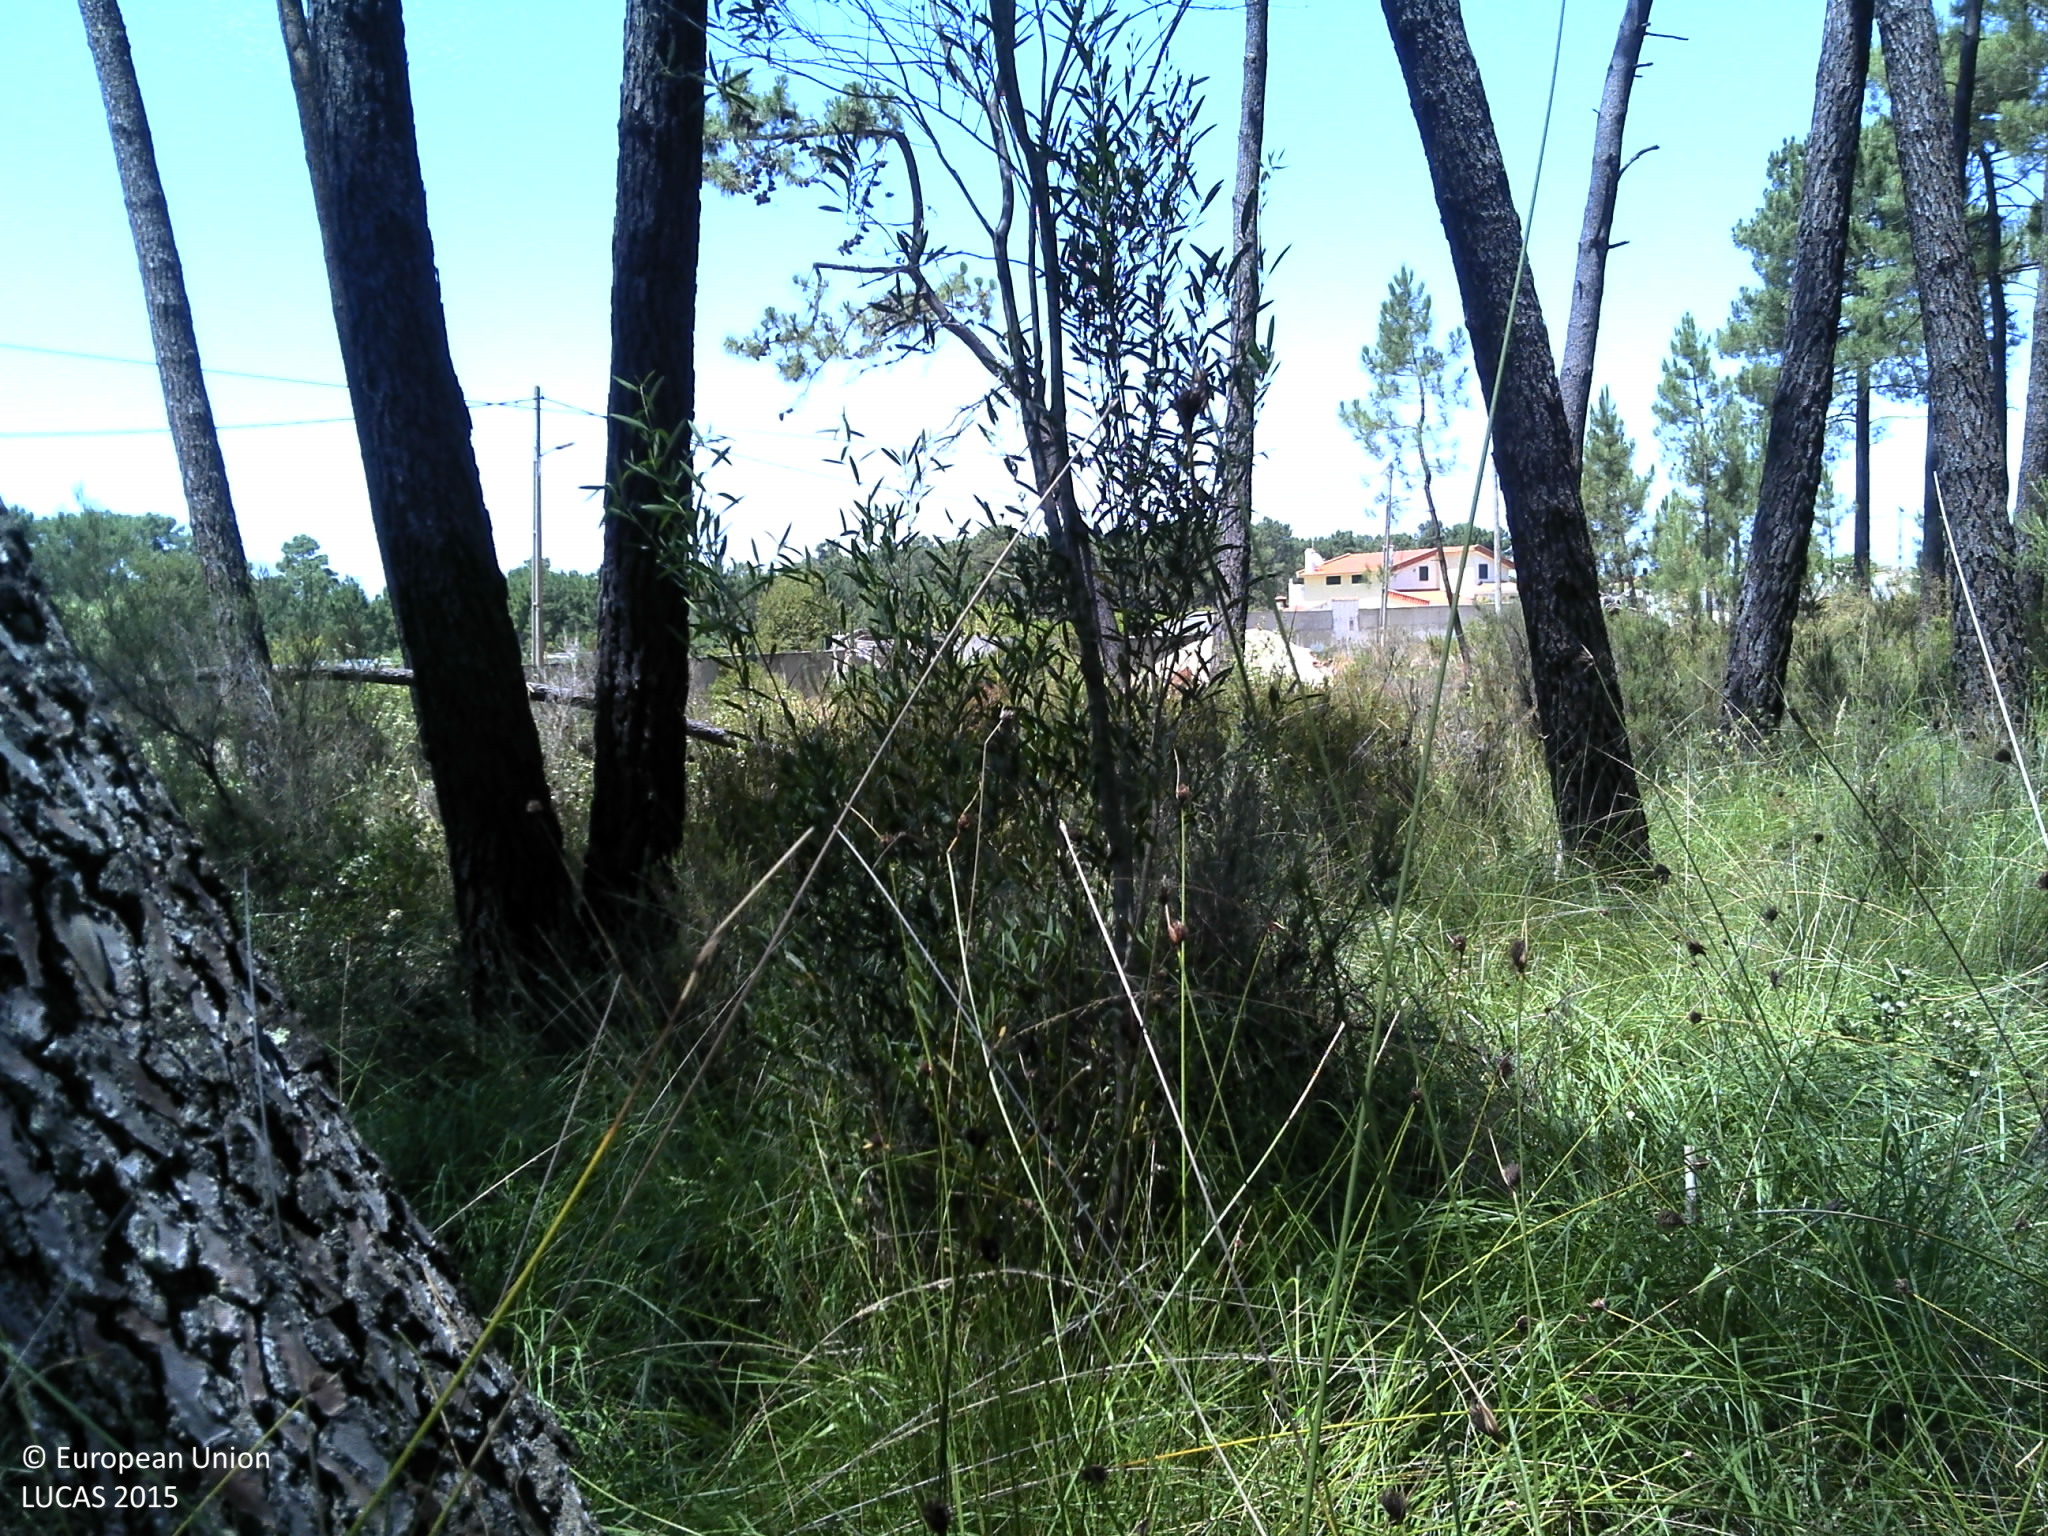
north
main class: Woodland
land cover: Pine dominated coniferous woodland
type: coniferous forest of the mediterranean region
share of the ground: > 75 %
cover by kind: coniferous forest trees 75 %, herbaceous plants 10 %, lichens and mosses 10 %, unconsolidated bare surface 5 %
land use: Forestry
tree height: > 5 m
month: June
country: PT
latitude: 38.5722
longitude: -9.1131
